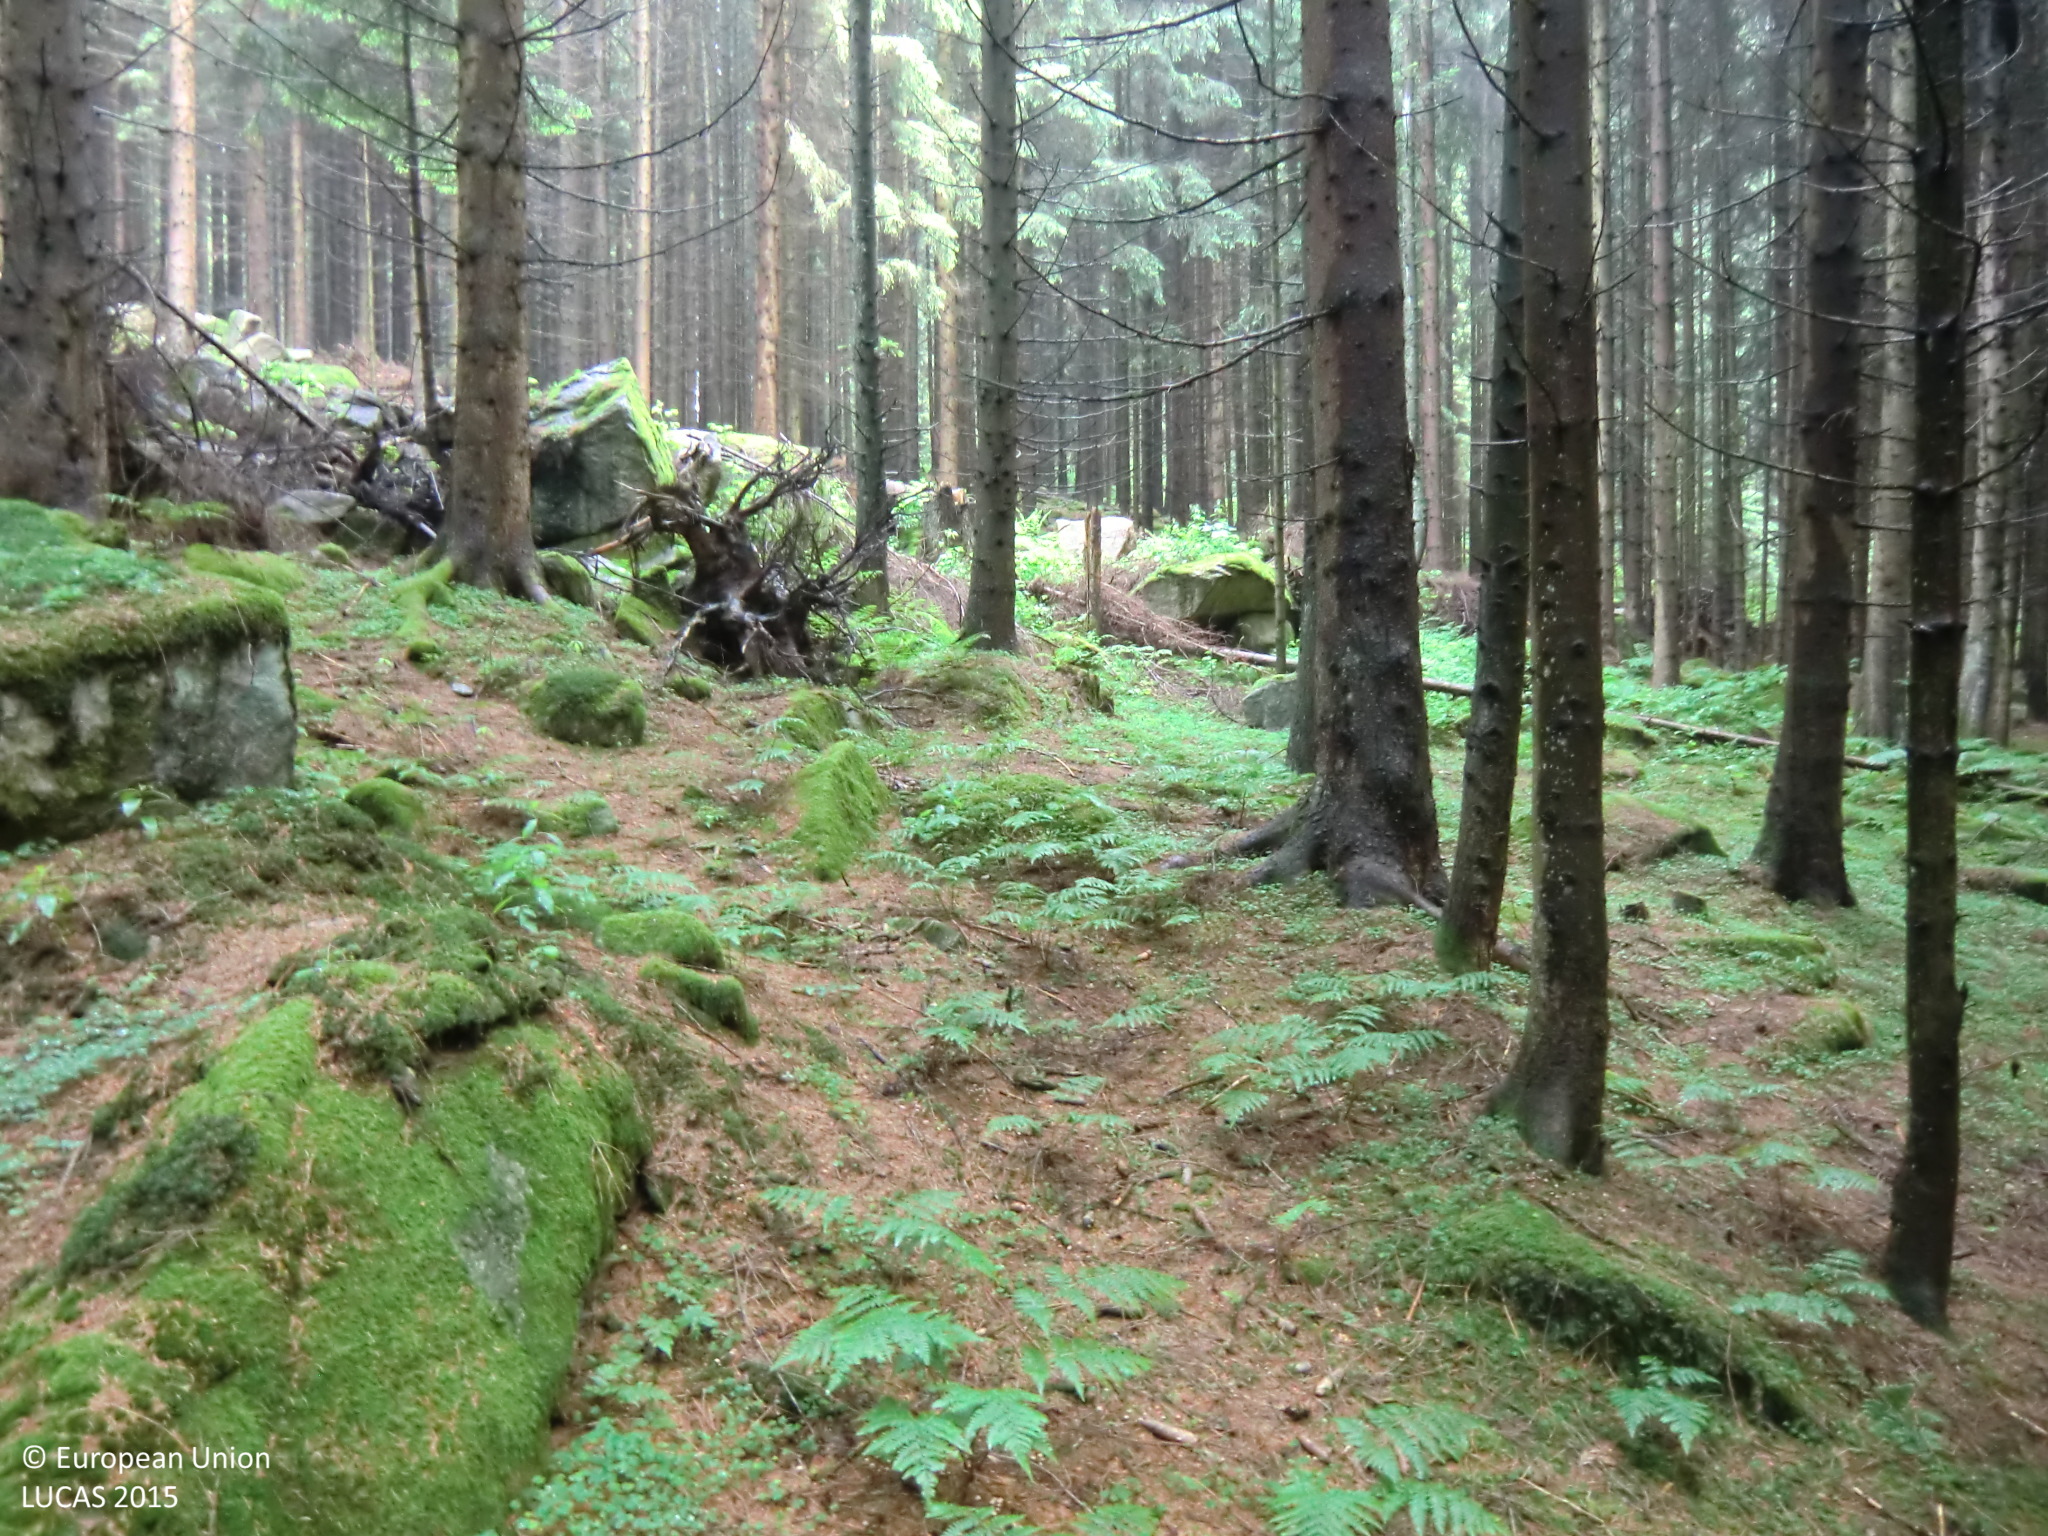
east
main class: Woodland
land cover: Spruce dominated coniferous woodland
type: hemiboreal forest and nemoral coniferous forest and mixed broadleaved-coniferous forest
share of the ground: > 75 %
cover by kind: coniferous forest trees 75 %, unconsolidated bare surface 15 %, herbaceous plants 10 %
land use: Forestry
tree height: > 5 m
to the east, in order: Spruce dominated coniferous woodland; Tracks; Spruce dominated coniferous woodland; Tracks; Spruce dominated coniferous woodland; Tracks; Spruce dominated coniferous woodland; Tracks; Spruce dominated coniferous woodland
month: June
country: AT
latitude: 48.5244
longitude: 14.5910
